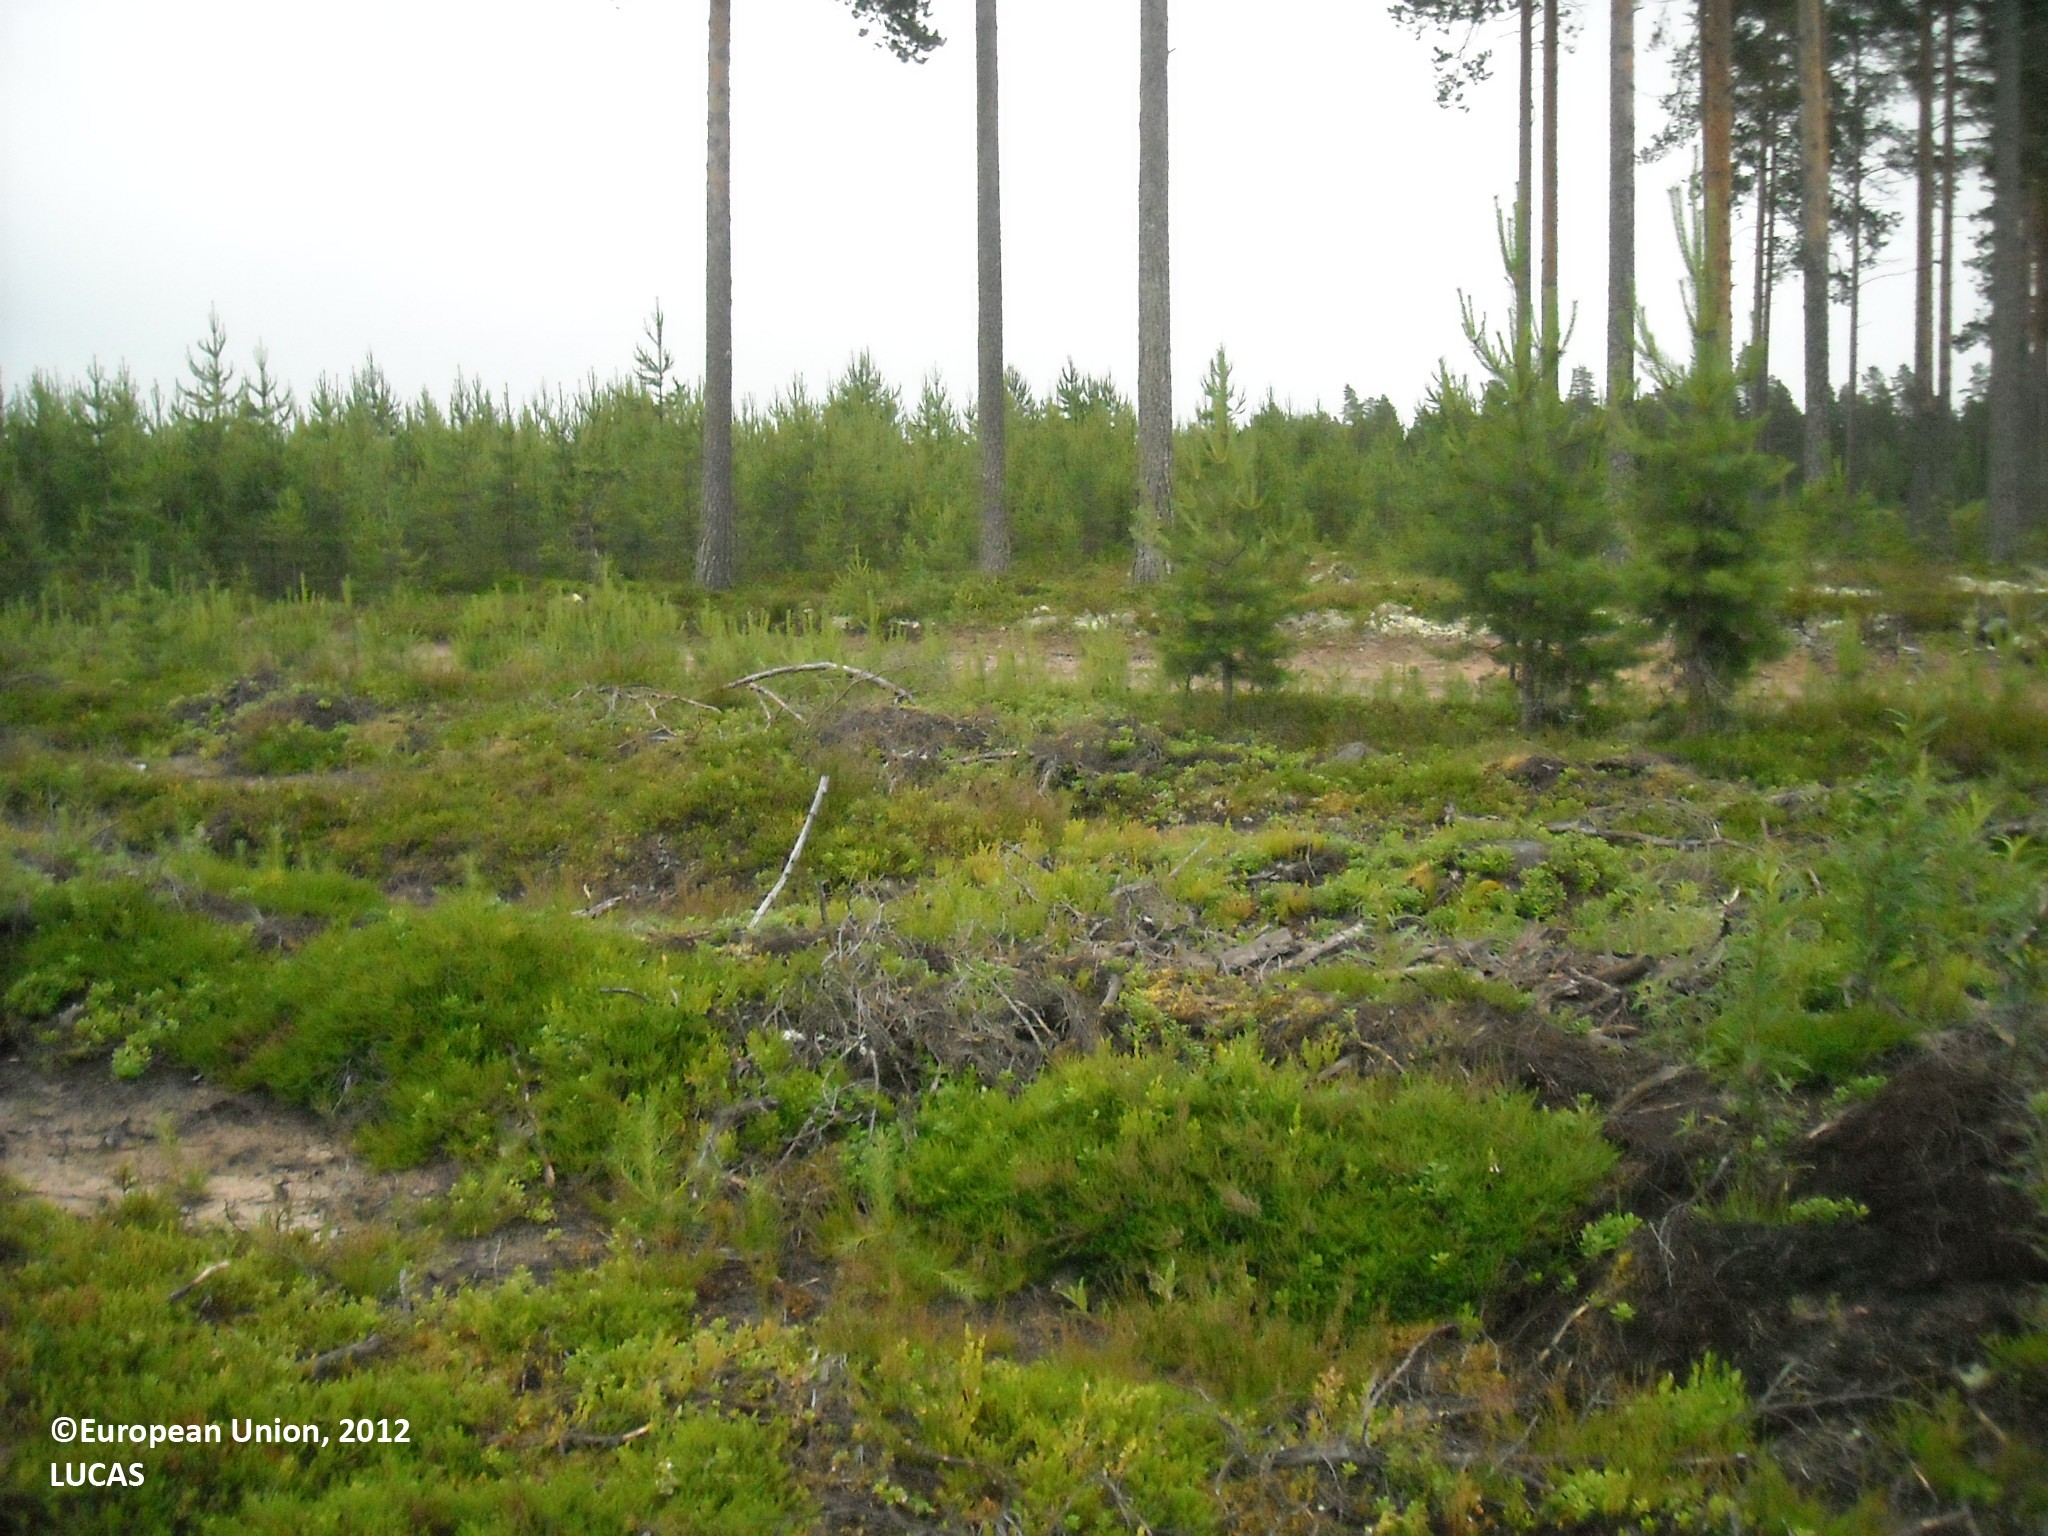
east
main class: Shrubland
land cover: Shrubland with sparse tree cover
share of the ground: > 75 %
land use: Forestry
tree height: < 5 m
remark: Clear cut
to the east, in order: Shrubland with sparse tree cover; Paved roads, cycling and walking lanes; Pine dominated coniferous woodland; Paved roads, cycling and walking lanes; Sand; Pine dominated coniferous woodland; Sand; Shrubland with sparse tree cover; Sand; Shrubland without tree cover; Sand
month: July
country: FI
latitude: 64.4040
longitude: 27.1239
